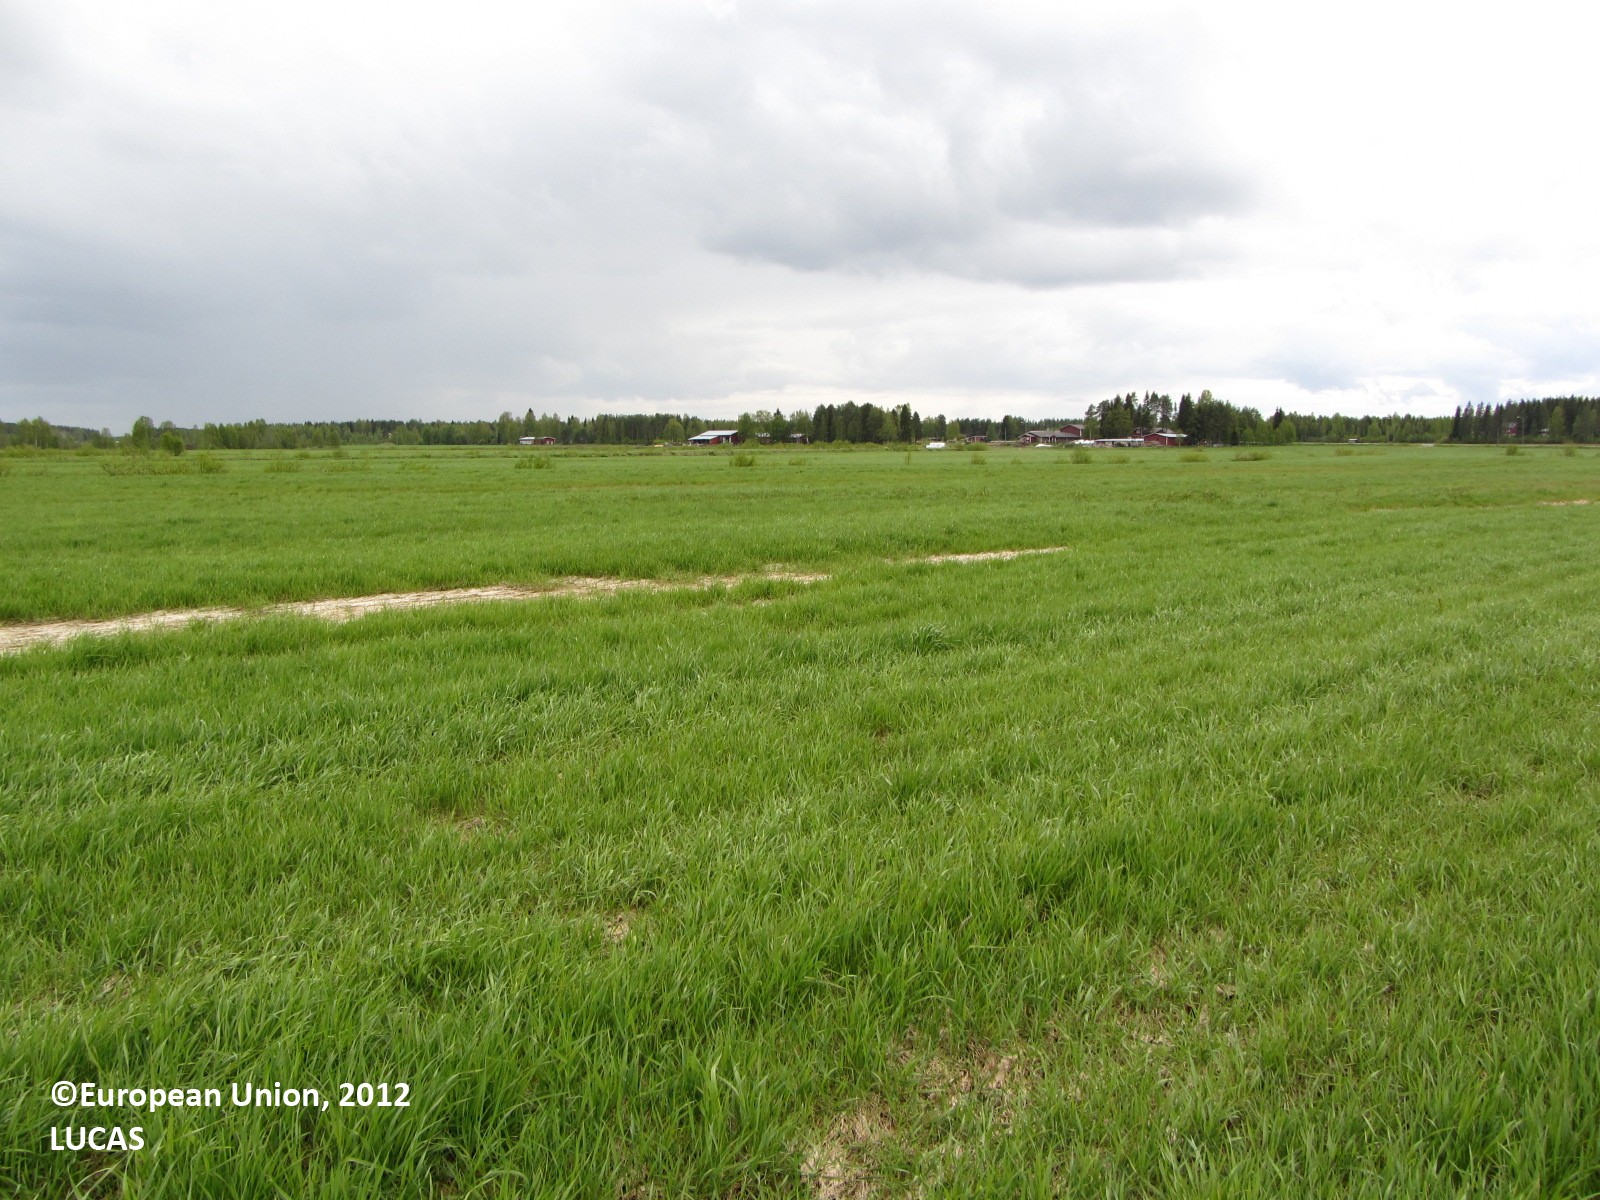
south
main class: Cropland
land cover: Barley
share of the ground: > 75 %
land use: Agriculture (excluding fallow land and kitchen gardens)
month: June
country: FI
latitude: 63.8240
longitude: 24.6476
